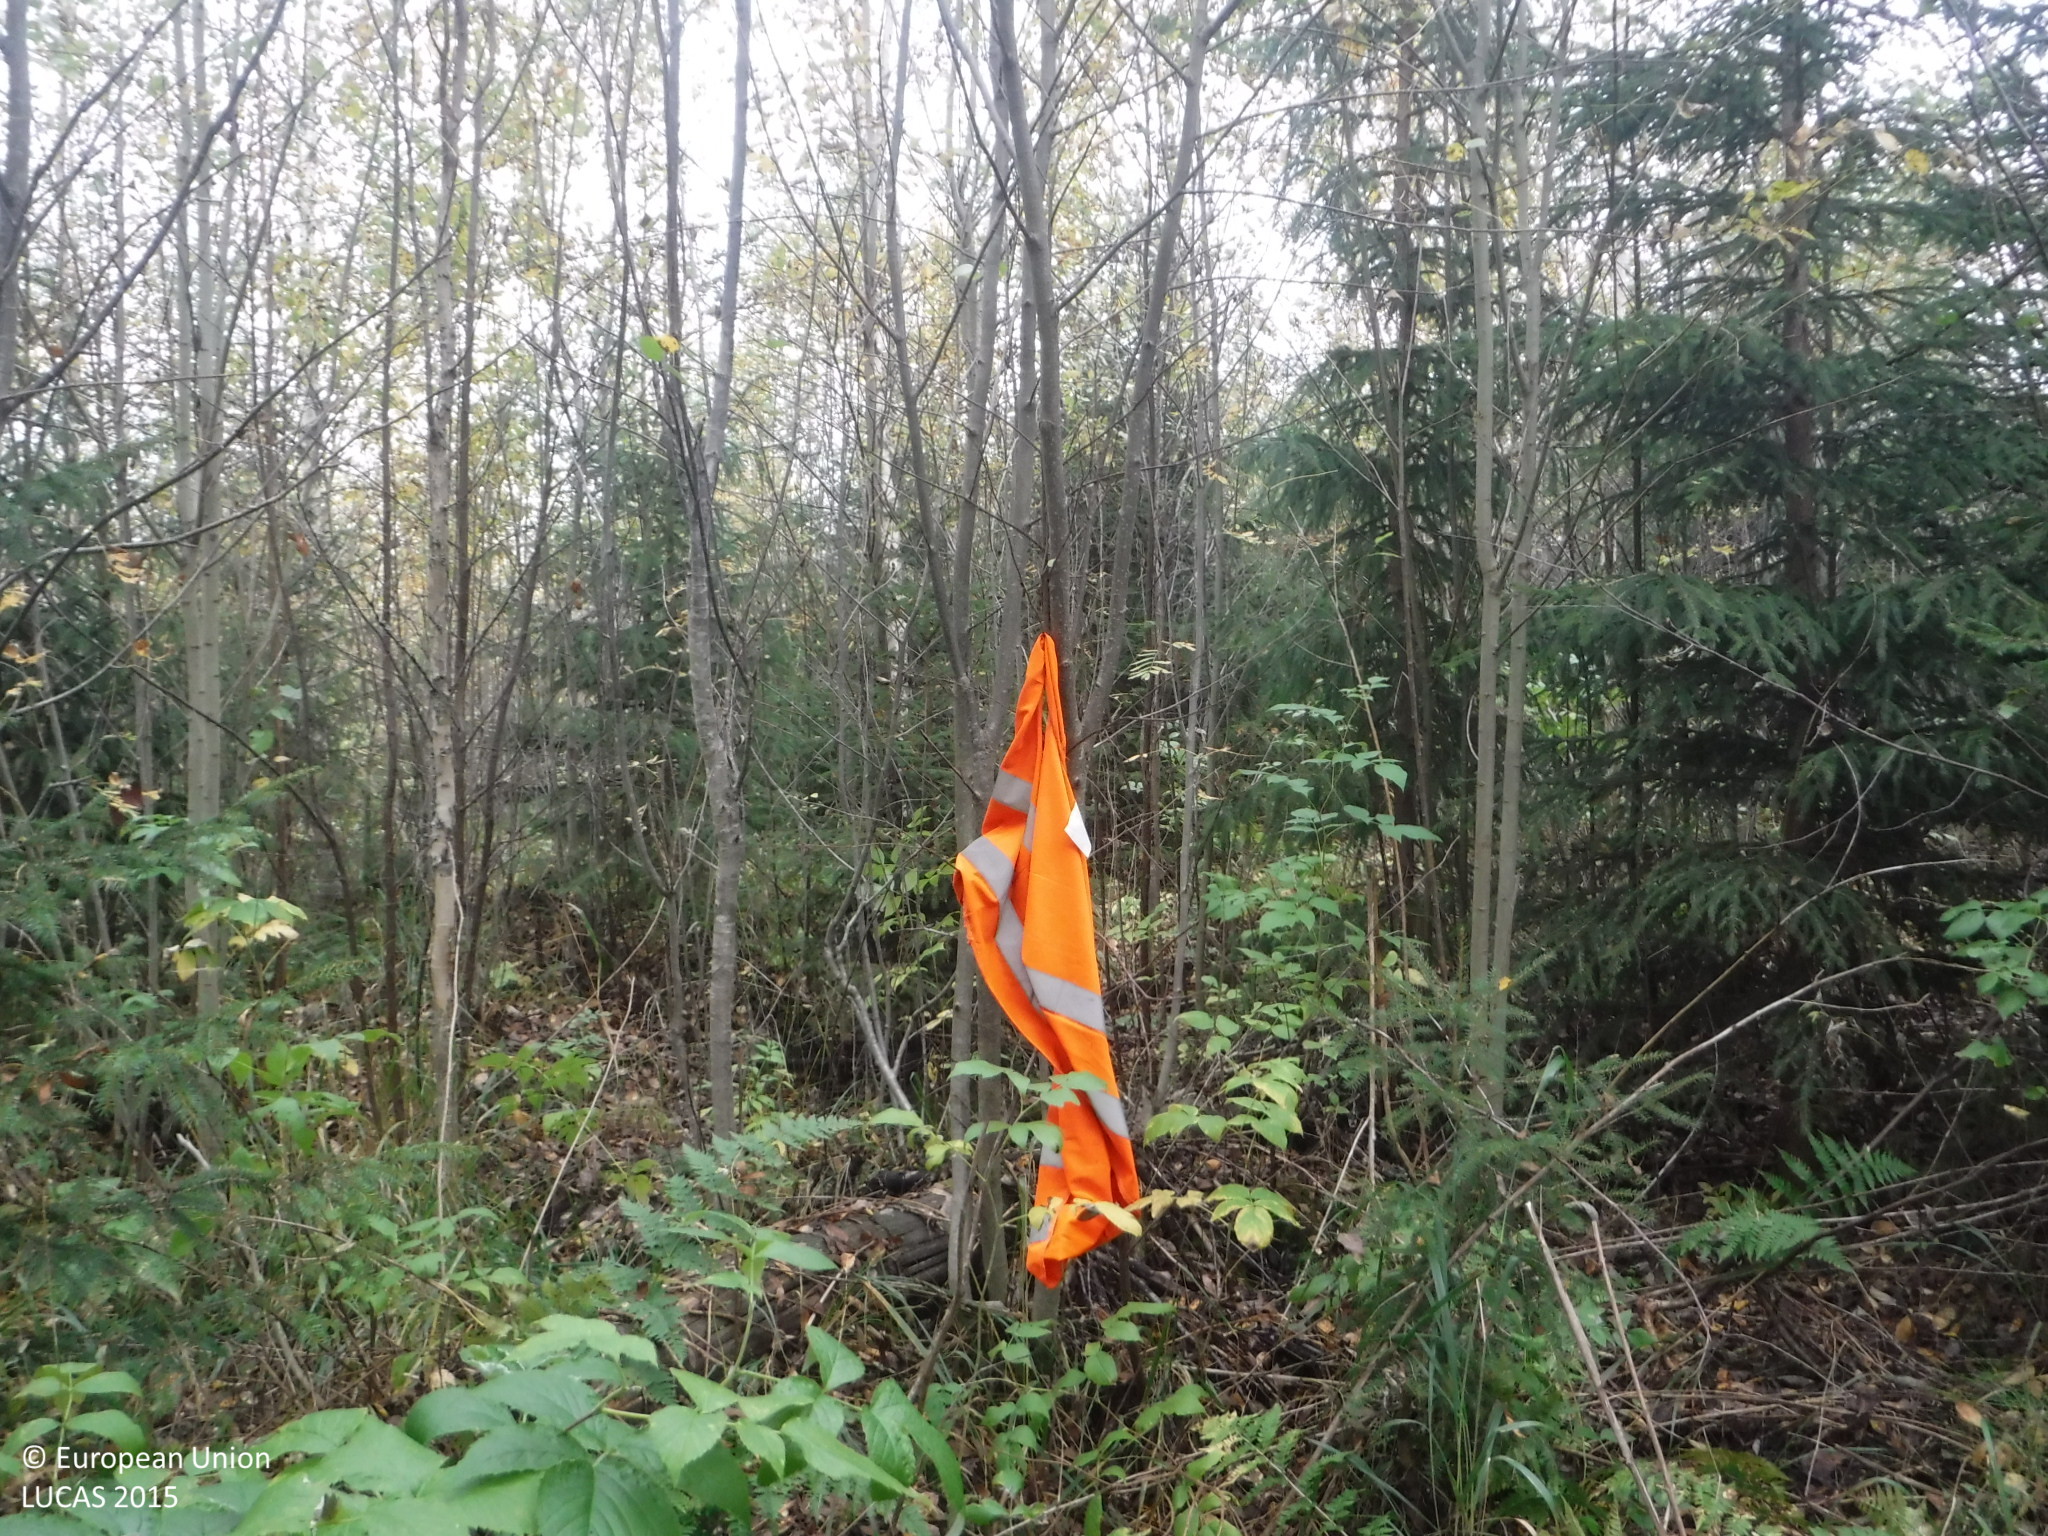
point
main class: Woodland
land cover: Broadleaved woodland
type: boreal forest
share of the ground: > 75 %
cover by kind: broadleaved forest trees 75 %, coniferous forest trees 10 %, lichens and mosses 10 %, shrubs 5 %
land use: Forestry
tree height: > 5 m
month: September
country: FI
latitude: 61.7405
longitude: 24.1182
